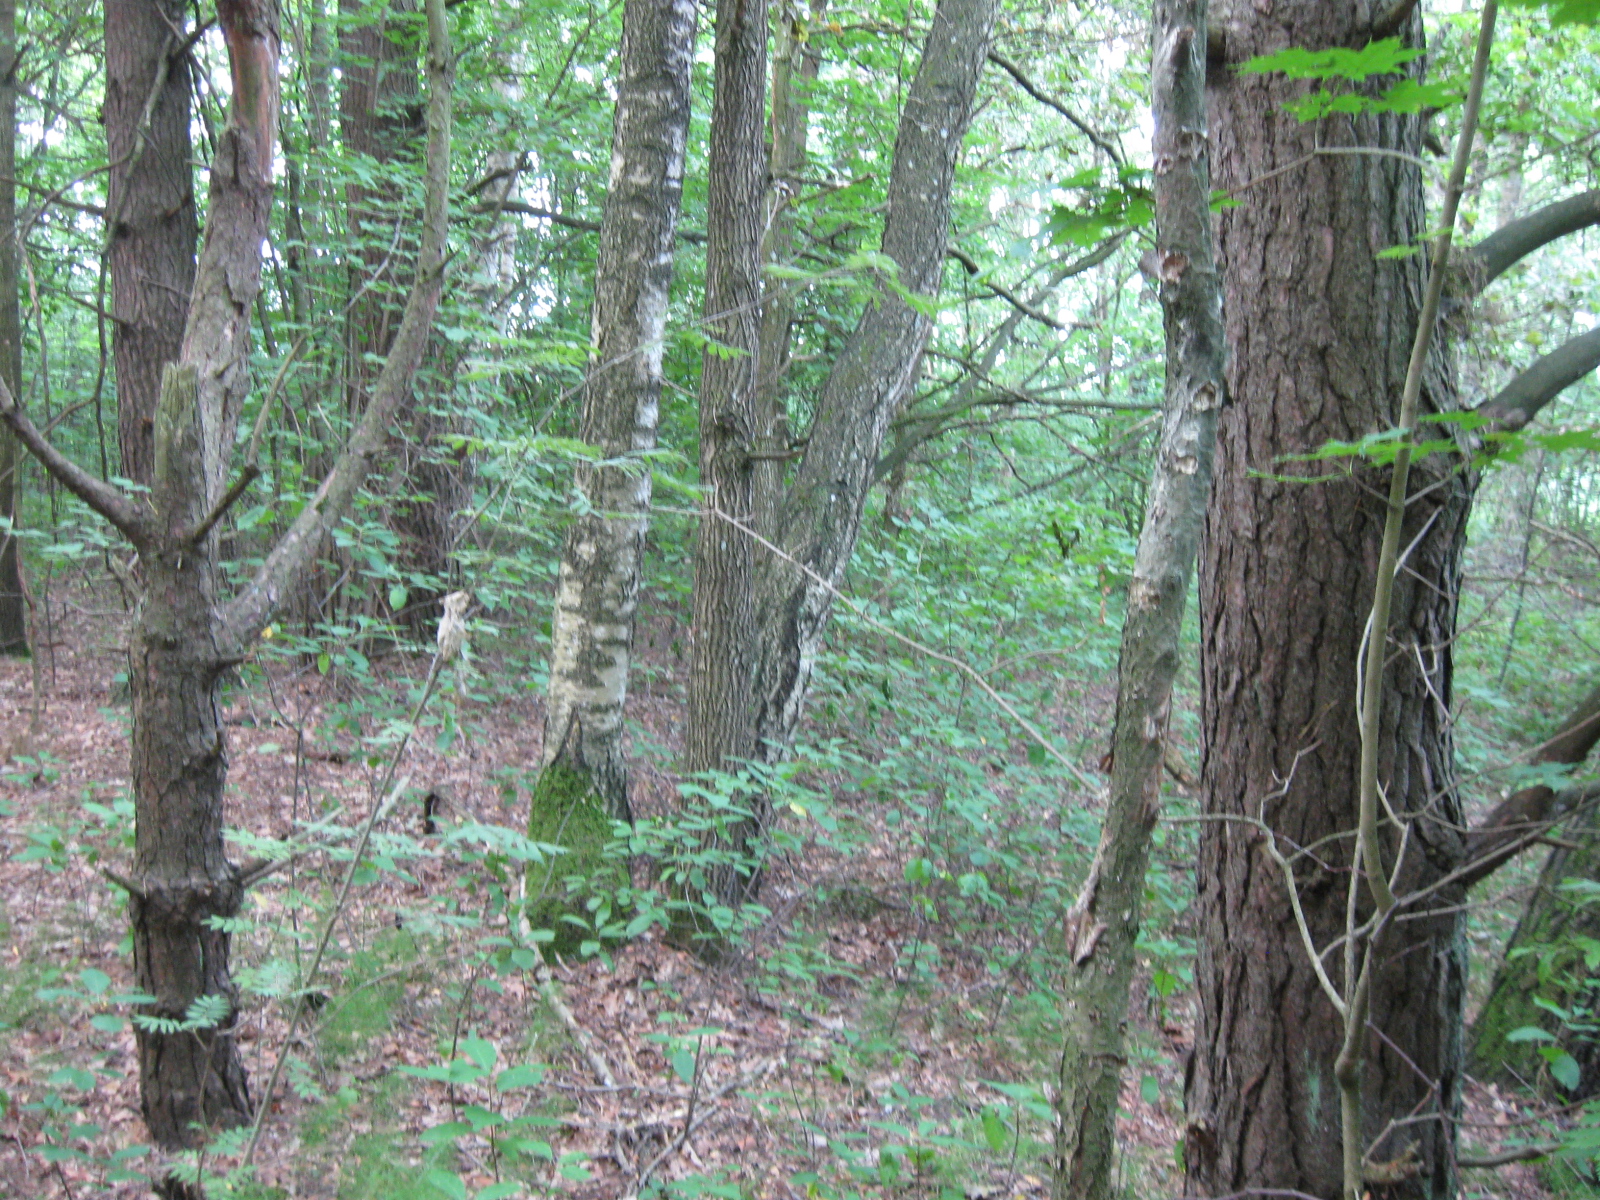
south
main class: Woodland
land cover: Pine dominated mixed woodland
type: hemiboreal forest and nemoral coniferous forest and mixed broadleaved-coniferous forest
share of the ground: > 75 %
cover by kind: coniferous forest trees 60 %, broadleaved forest trees 30 %, herbaceous plants 5 %, unconsolidated bare surface 5 %
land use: Forestry
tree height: > 5 m
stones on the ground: < 10 %
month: July
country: LT
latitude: 54.7739
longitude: 23.6873
